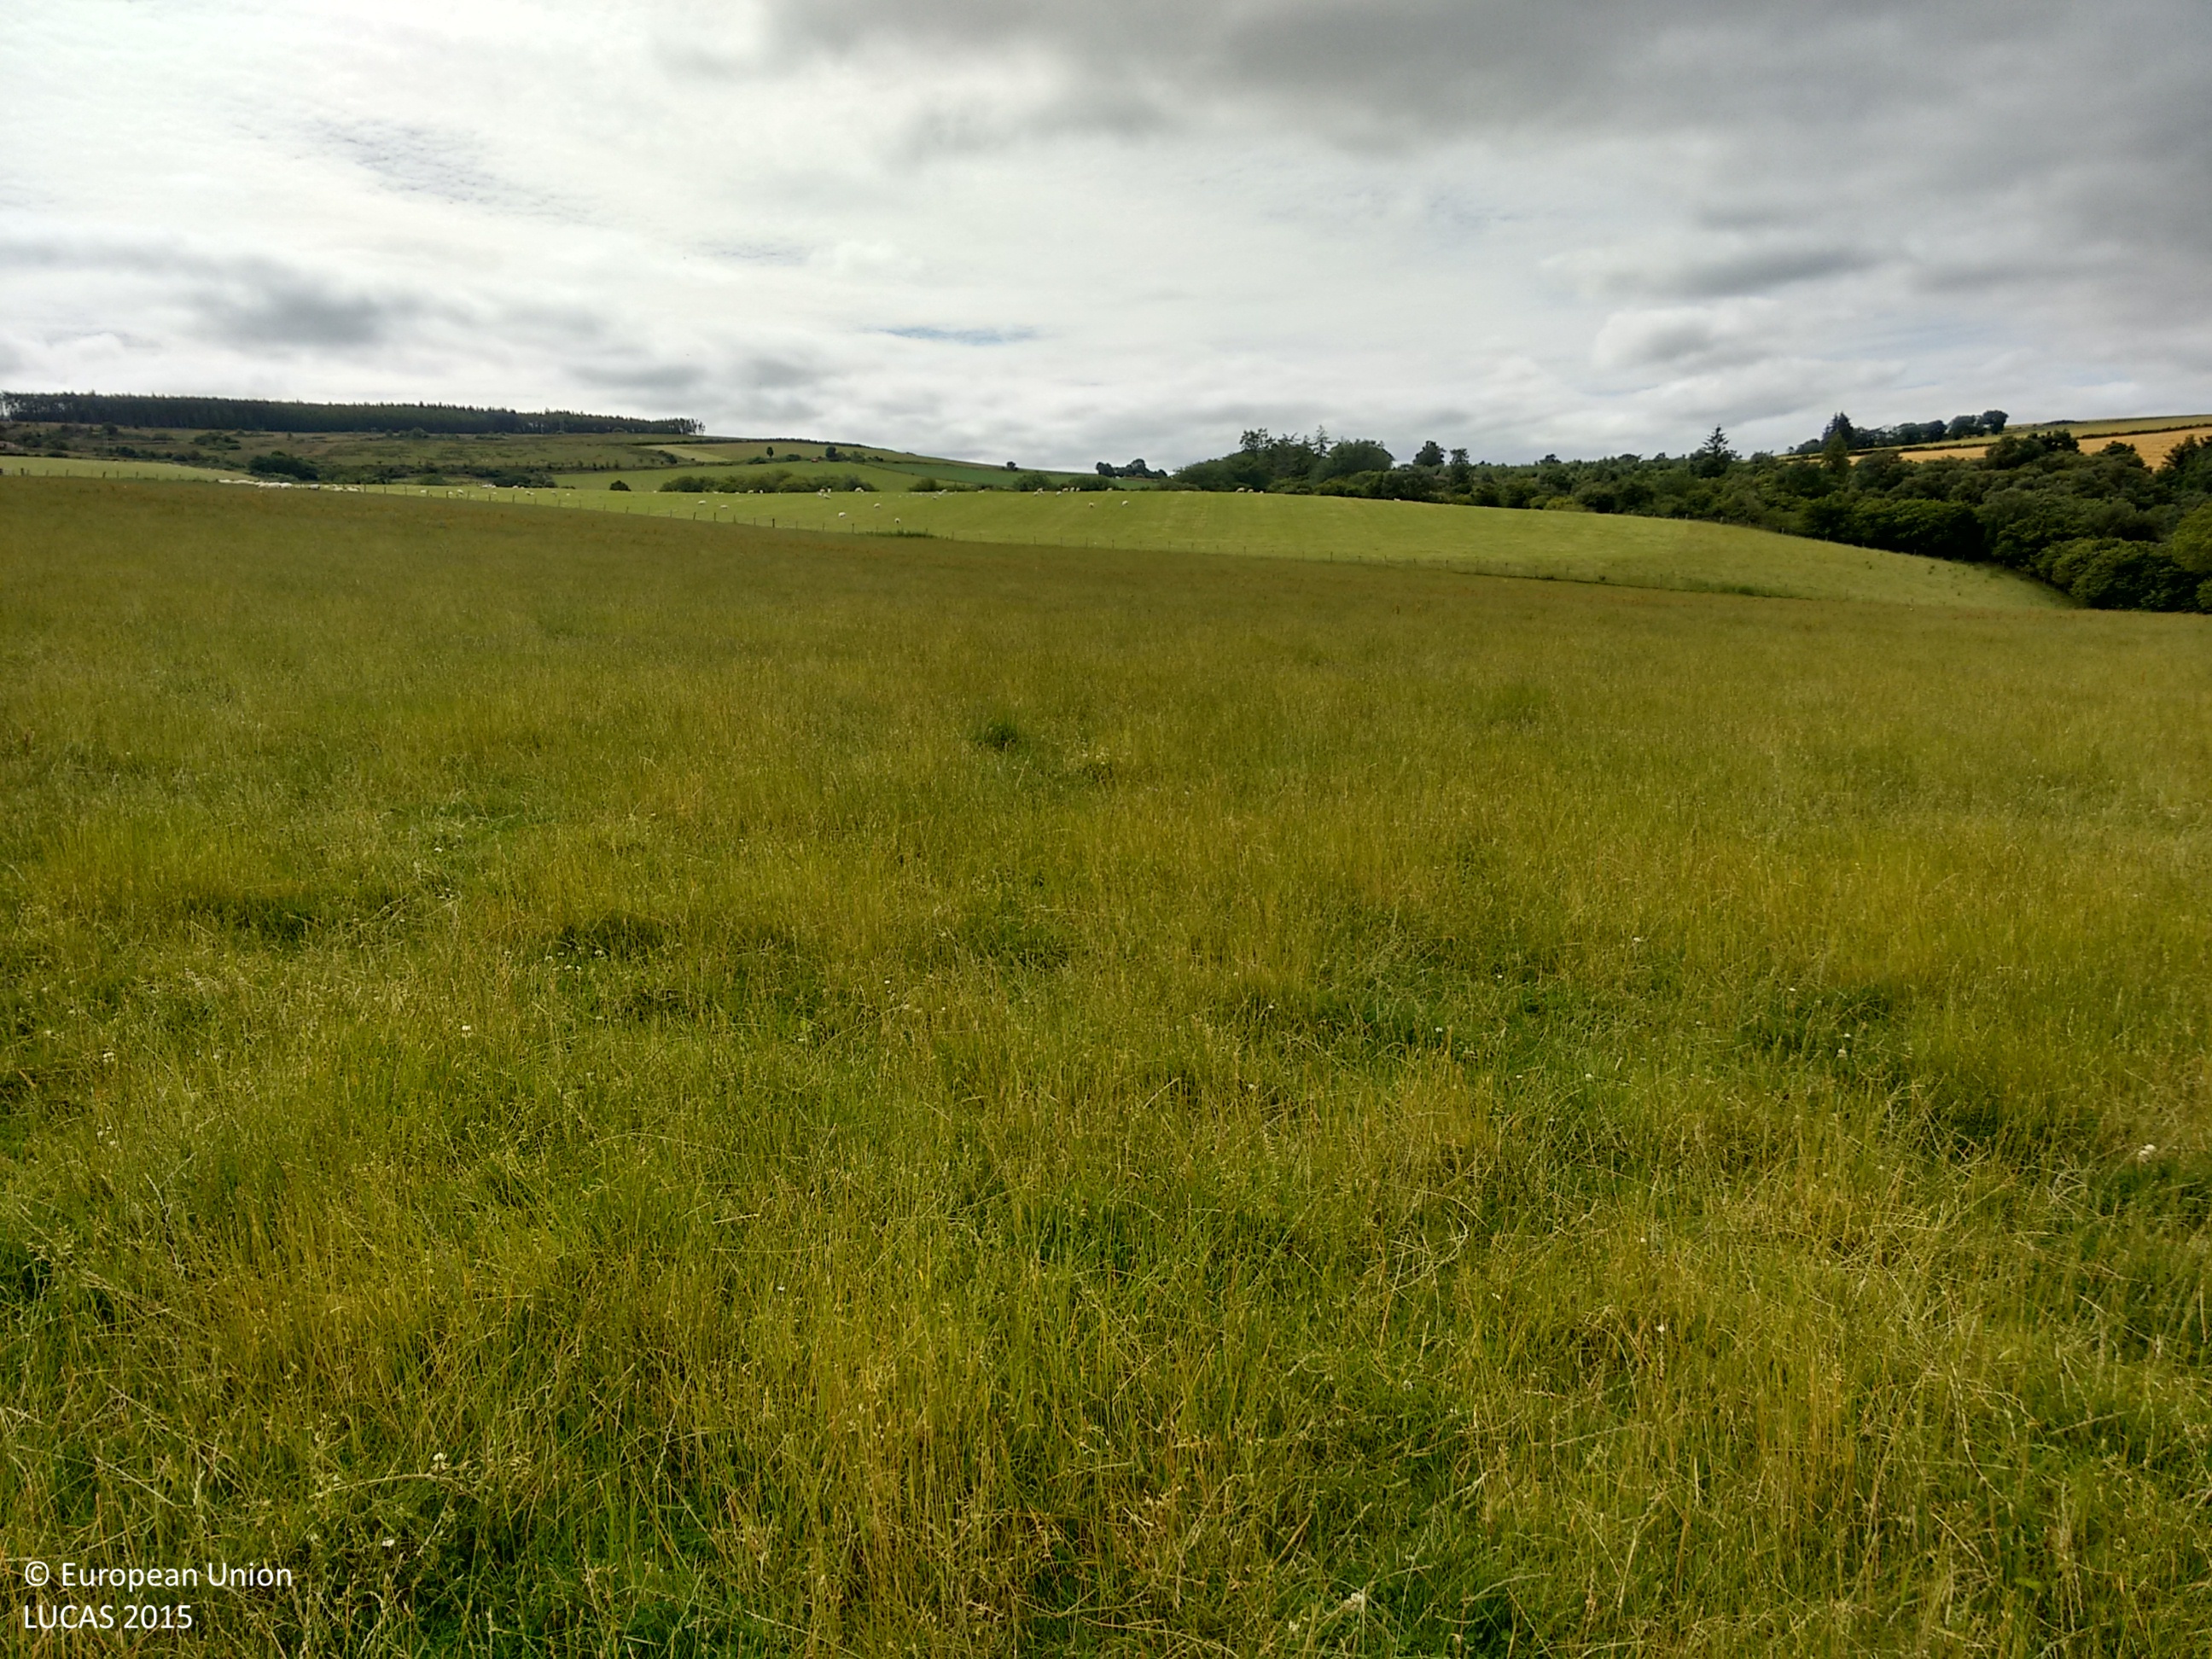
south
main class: Grassland
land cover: Grassland without tree/shrub cover
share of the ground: > 75 %
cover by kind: herbaceous plants 100 %
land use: Agriculture (excluding fallow land and kitchen gardens)
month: August
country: GB
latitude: 57.6208
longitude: -3.0026
